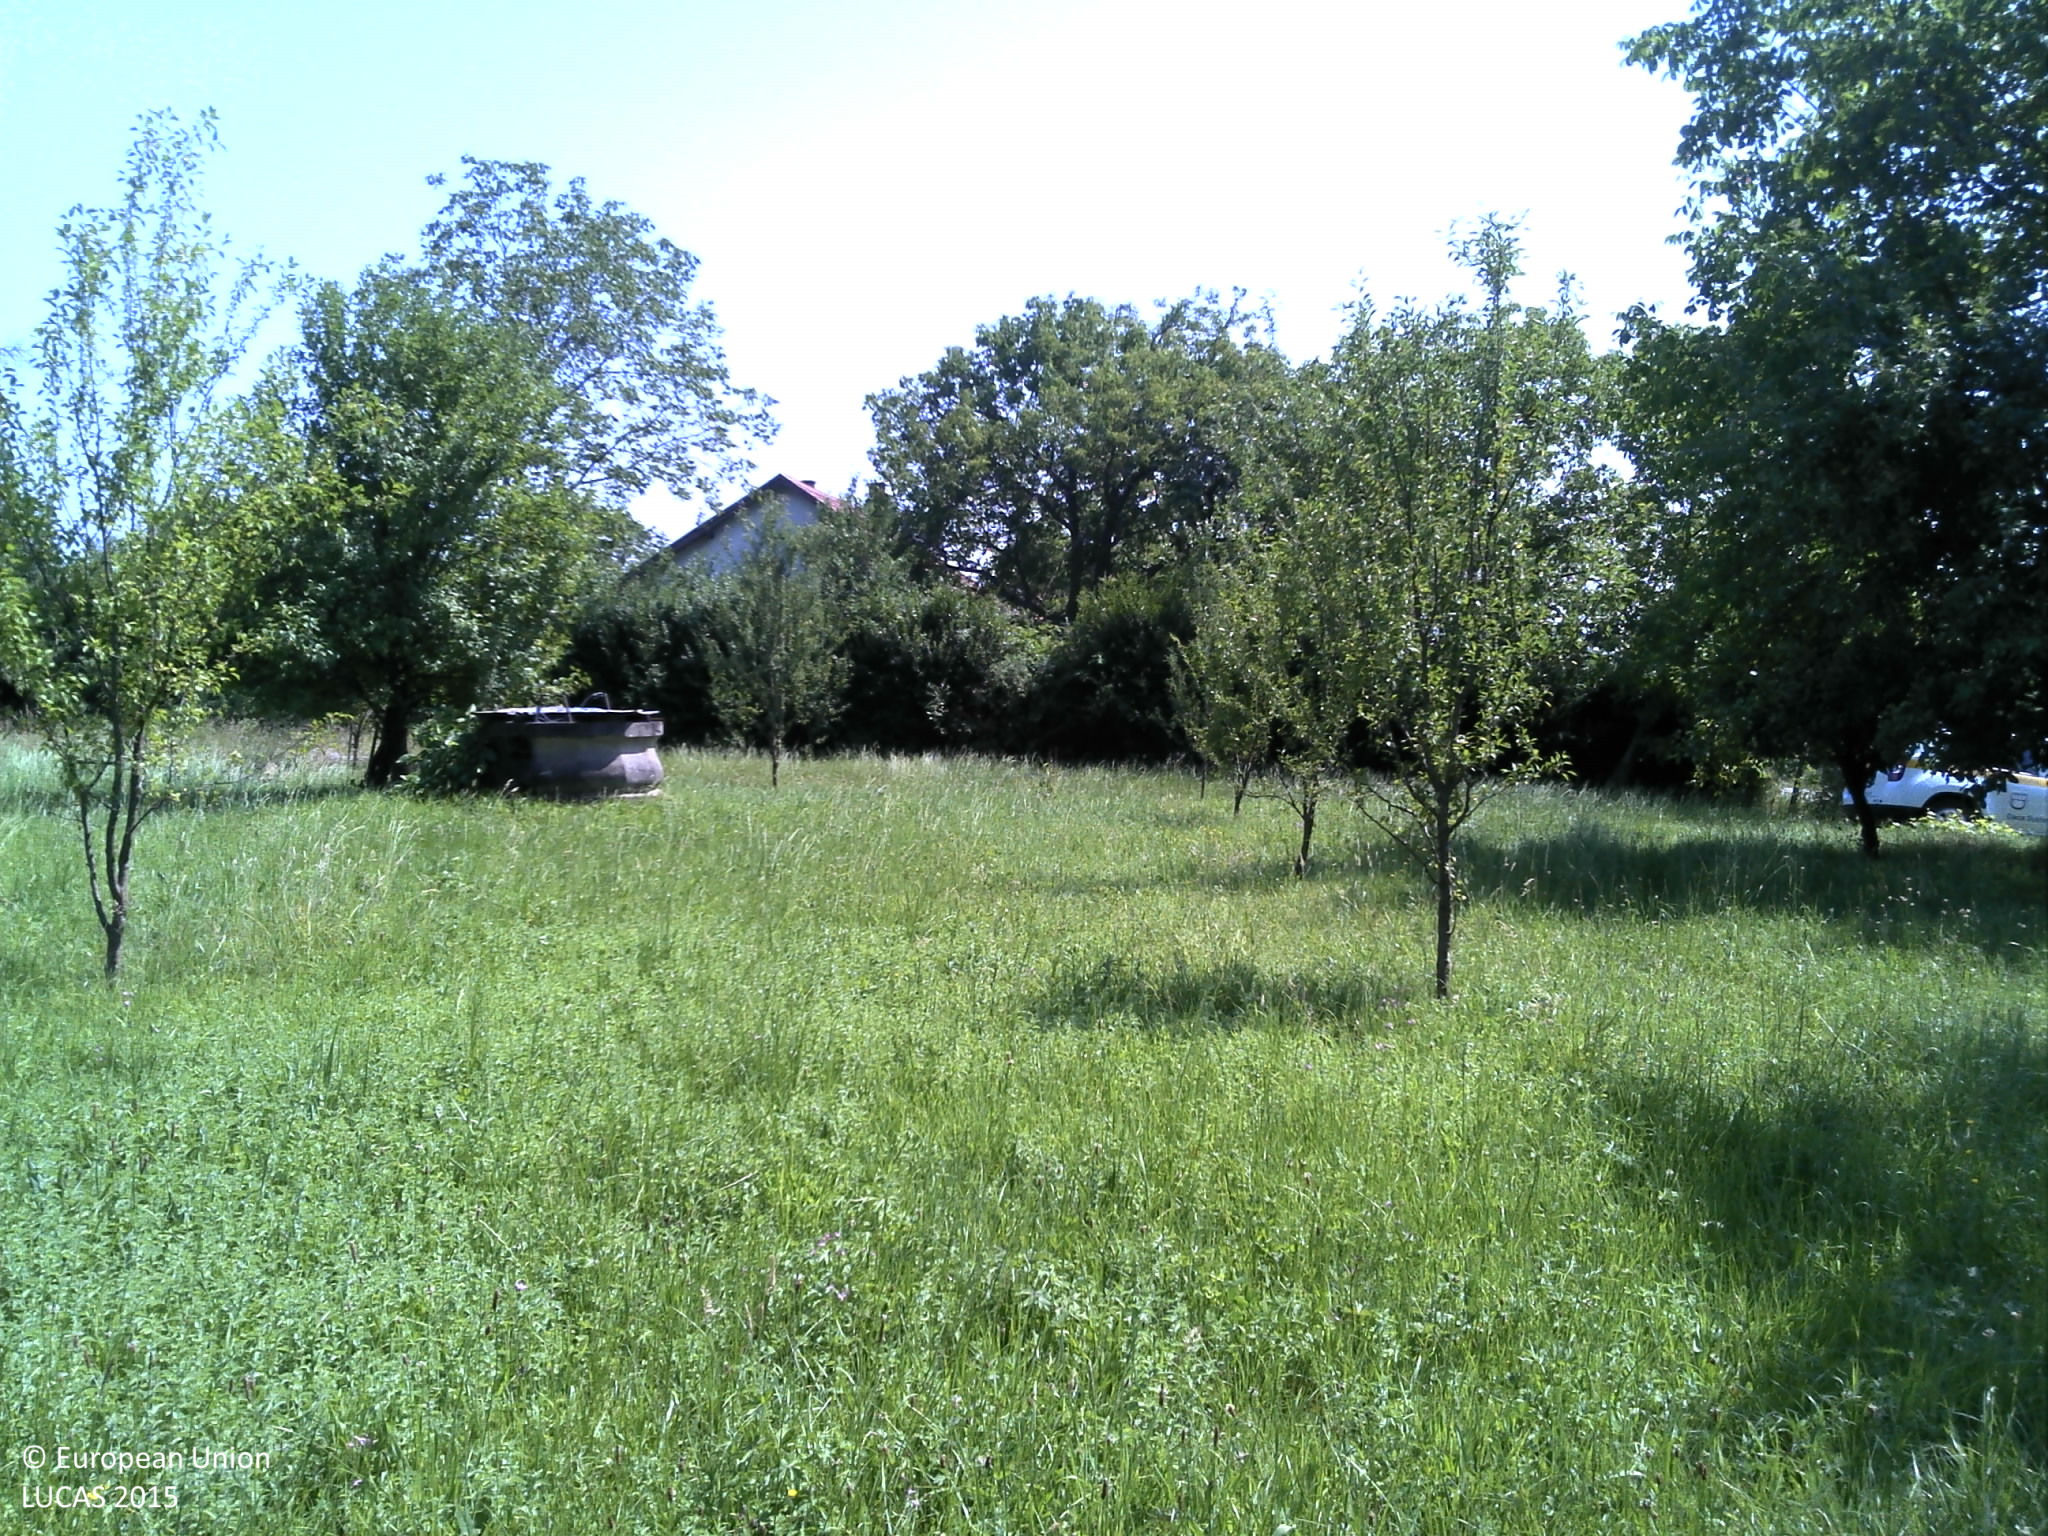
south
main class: Grassland
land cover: Grassland without tree/shrub cover
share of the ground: > 75 %
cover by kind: herbaceous plants 100 %
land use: Semi-natural and natural areas not in use
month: July
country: HR
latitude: 45.7649
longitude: 16.6471
